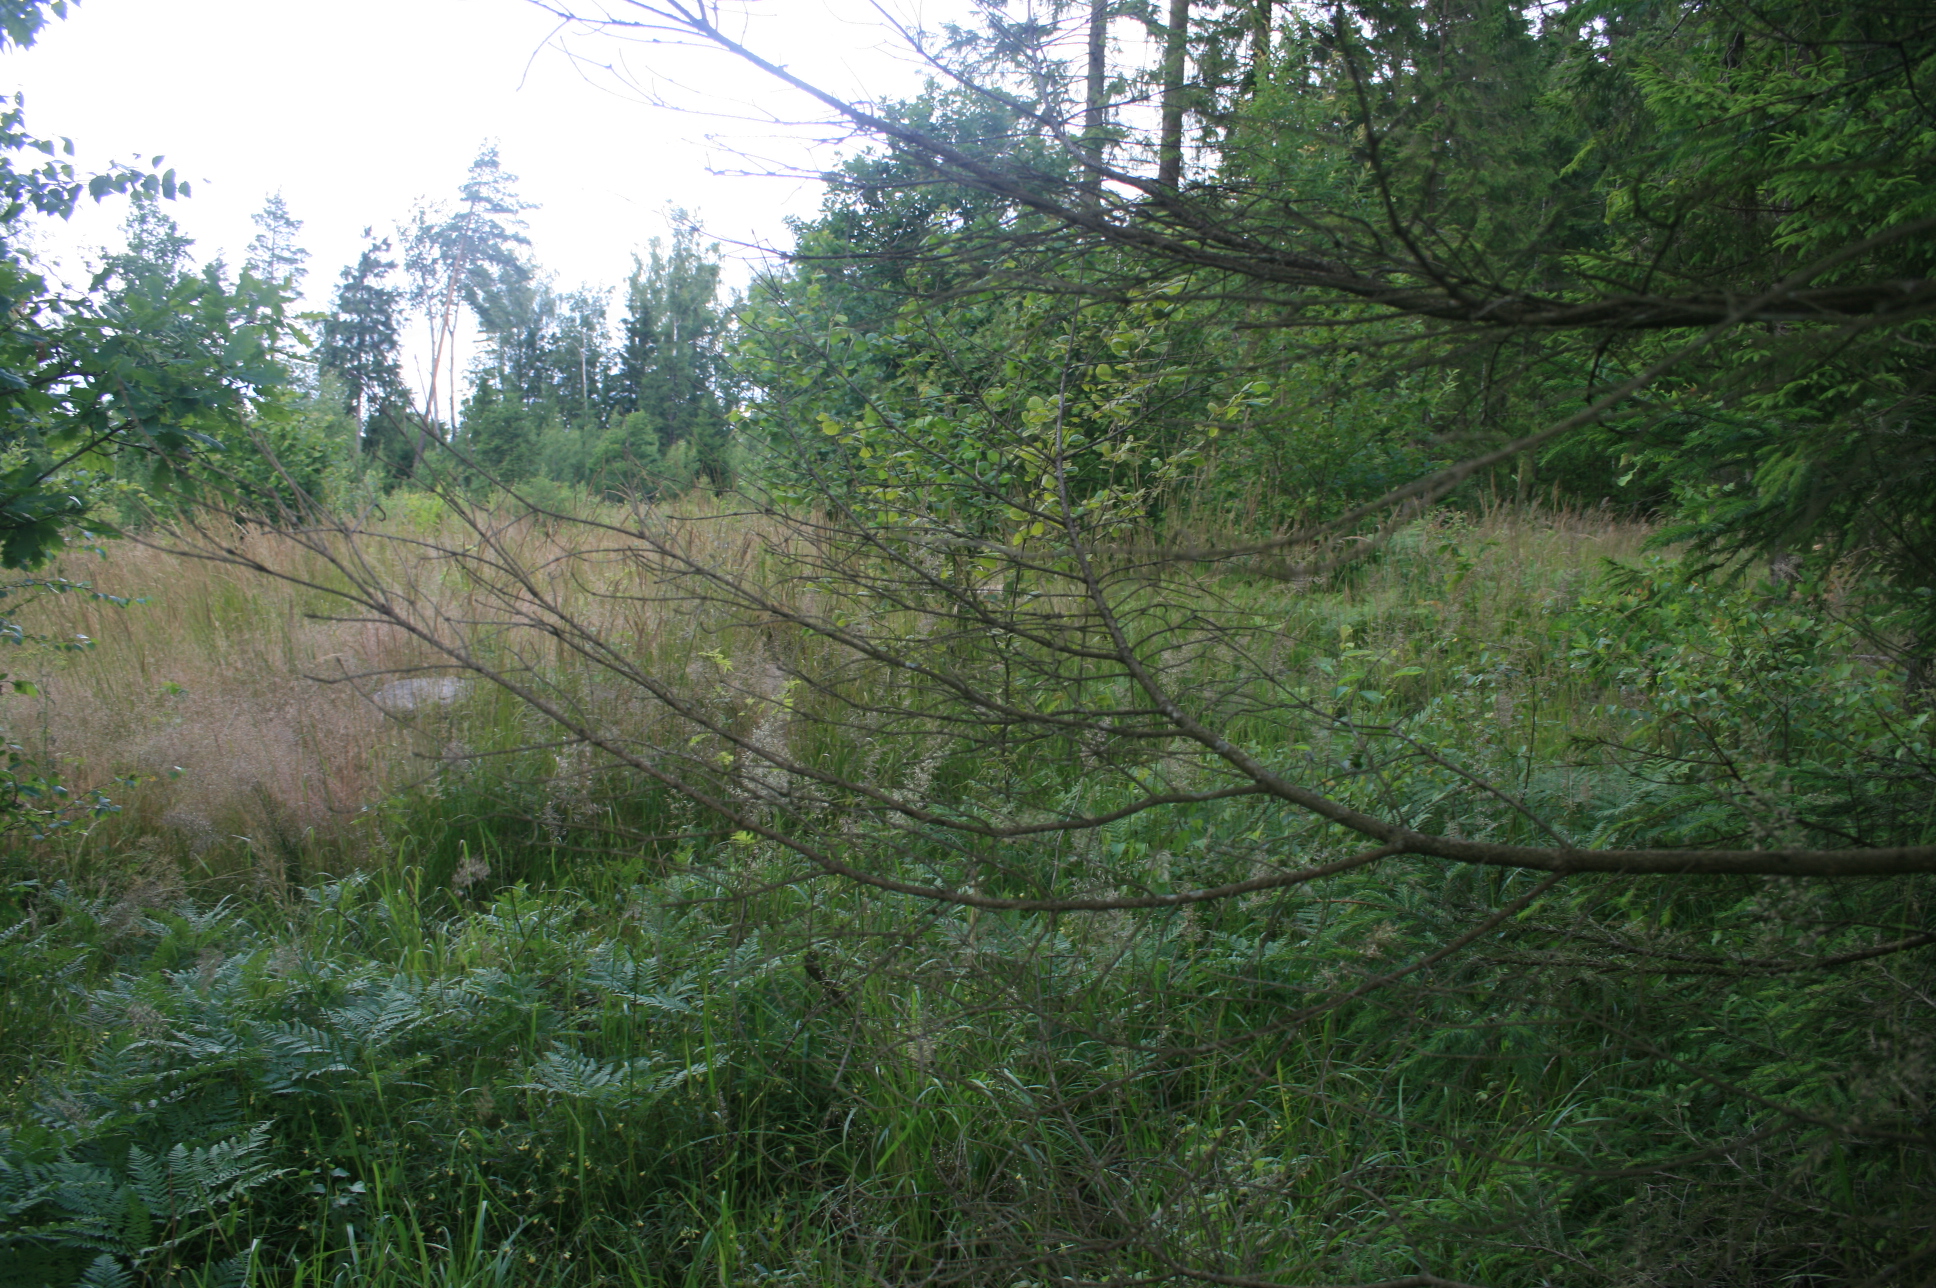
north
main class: Woodland
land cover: Spruce dominated mixed woodland
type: hemiboreal forest and nemoral coniferous forest and mixed broadleaved-coniferous forest
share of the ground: 50 - 75 %
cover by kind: coniferous forest trees 45 %, herbaceous plants 30 %, broadleaved forest trees 25 %
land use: Forestry
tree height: > 5 m
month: July
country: LT
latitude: 55.8268
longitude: 21.3608
